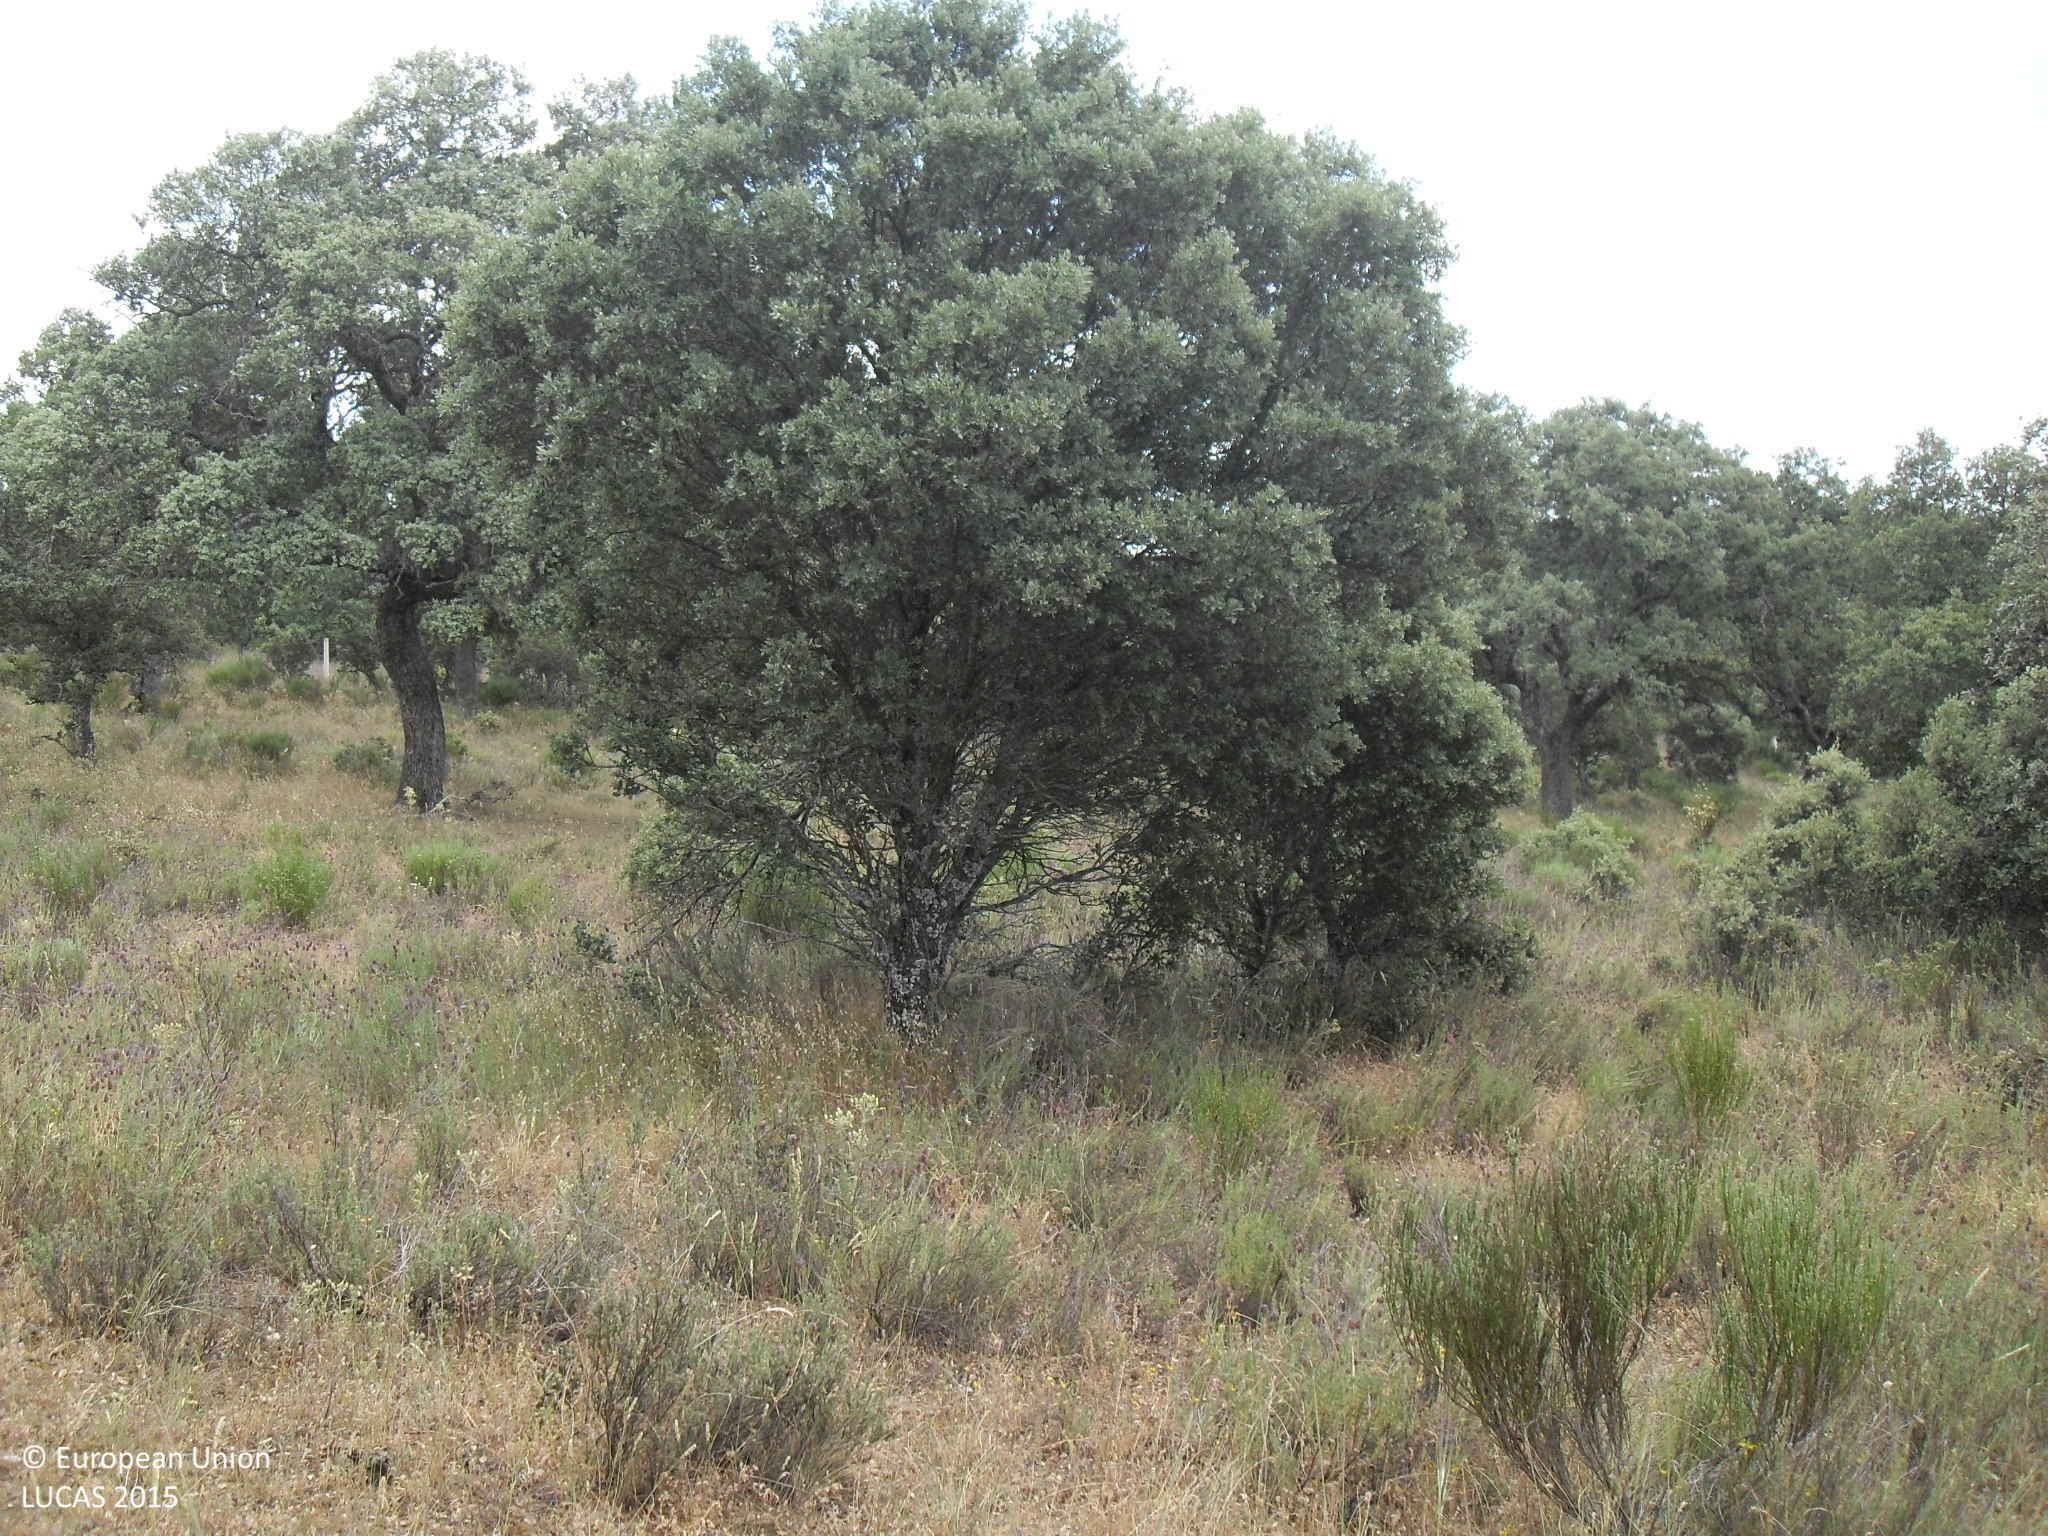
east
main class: Woodland
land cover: Broadleaved woodland
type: broadleaved evergreen forest
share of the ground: 25 - 50 %
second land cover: Grassland without tree/shrub cover
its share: 50 - 75 %
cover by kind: herbaceous plants 65 %, broadleaved forest trees 35 %
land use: Forestry
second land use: Agriculture (excluding fallow land and kitchen gardens)
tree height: > 5 m
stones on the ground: < 10 %
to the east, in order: Broadleaved woodland; Grassland without tree/shrub cover; Broadleaved woodland; Fences; Broadleaved woodland; Dry stone walls; Broadleaved woodland
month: June
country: ES
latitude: 40.5095
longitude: -5.5399
